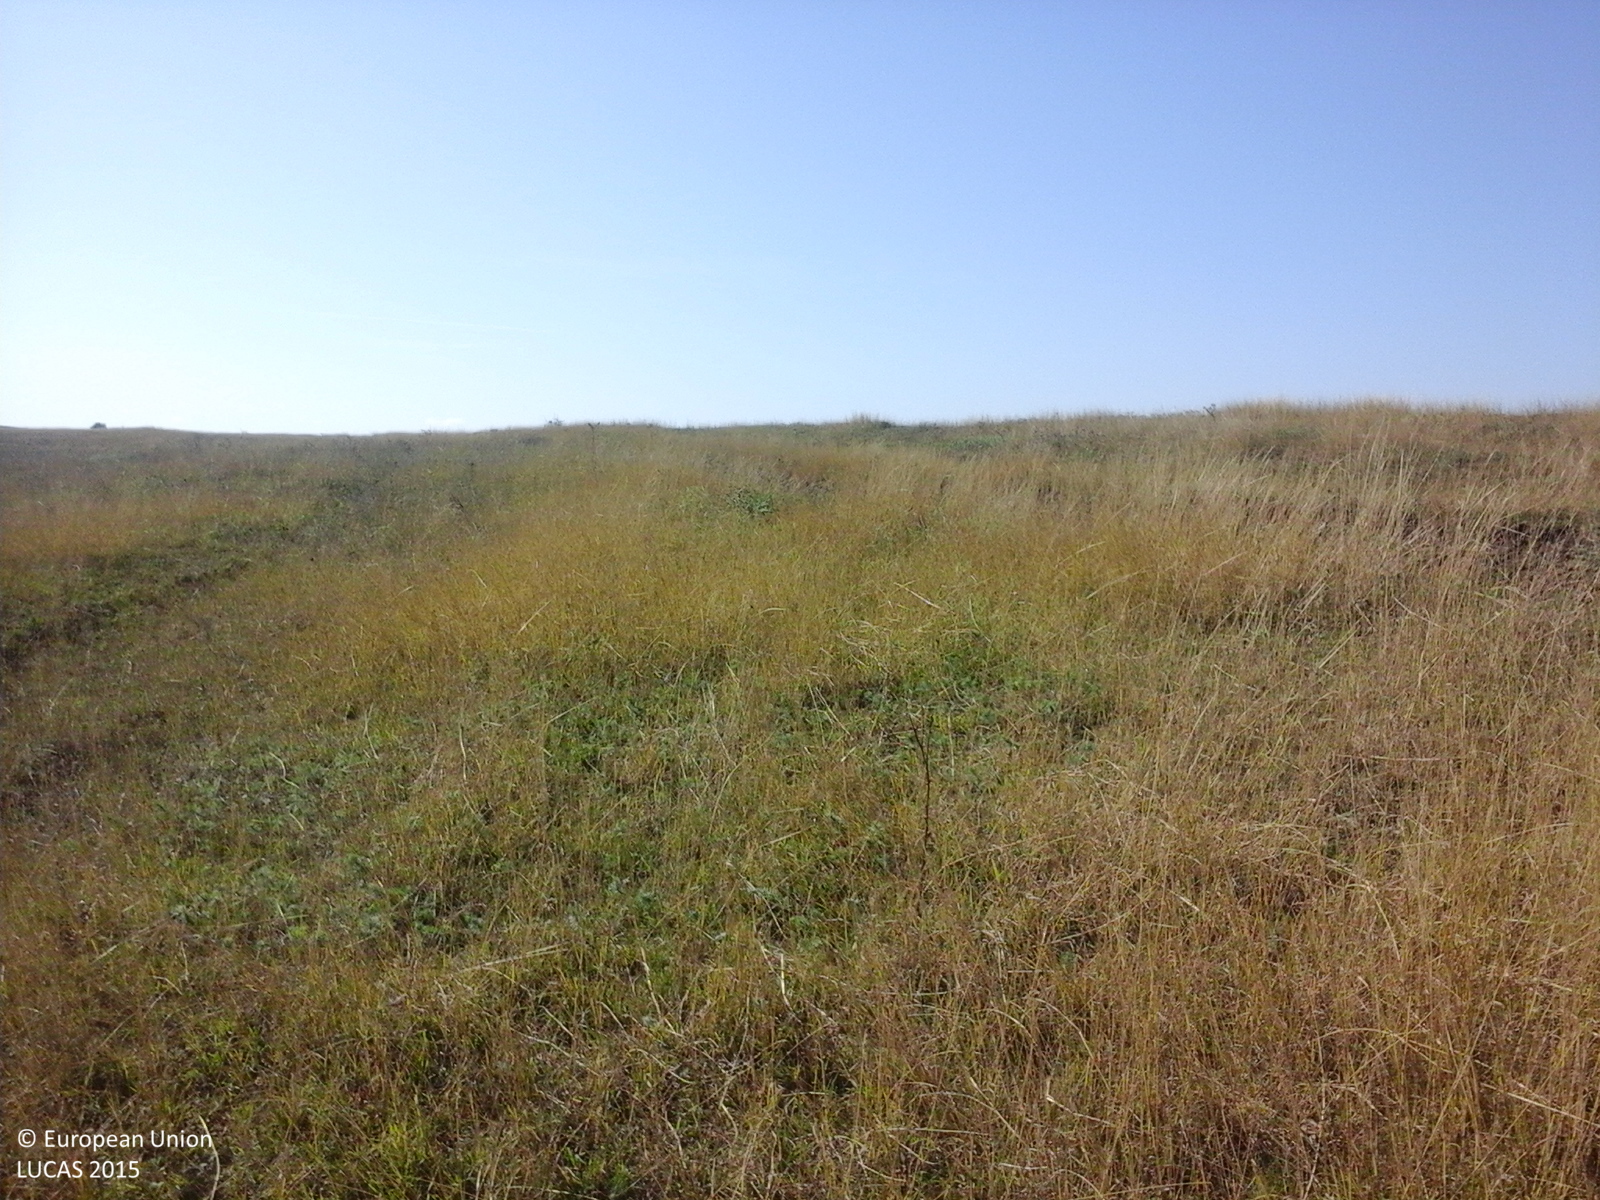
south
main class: Grassland
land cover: Grassland without tree/shrub cover
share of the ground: > 75 %
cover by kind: herbaceous plants 100 %
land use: Agriculture (excluding fallow land and kitchen gardens)
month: October
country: RO
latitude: 46.1346
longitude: 23.8833
